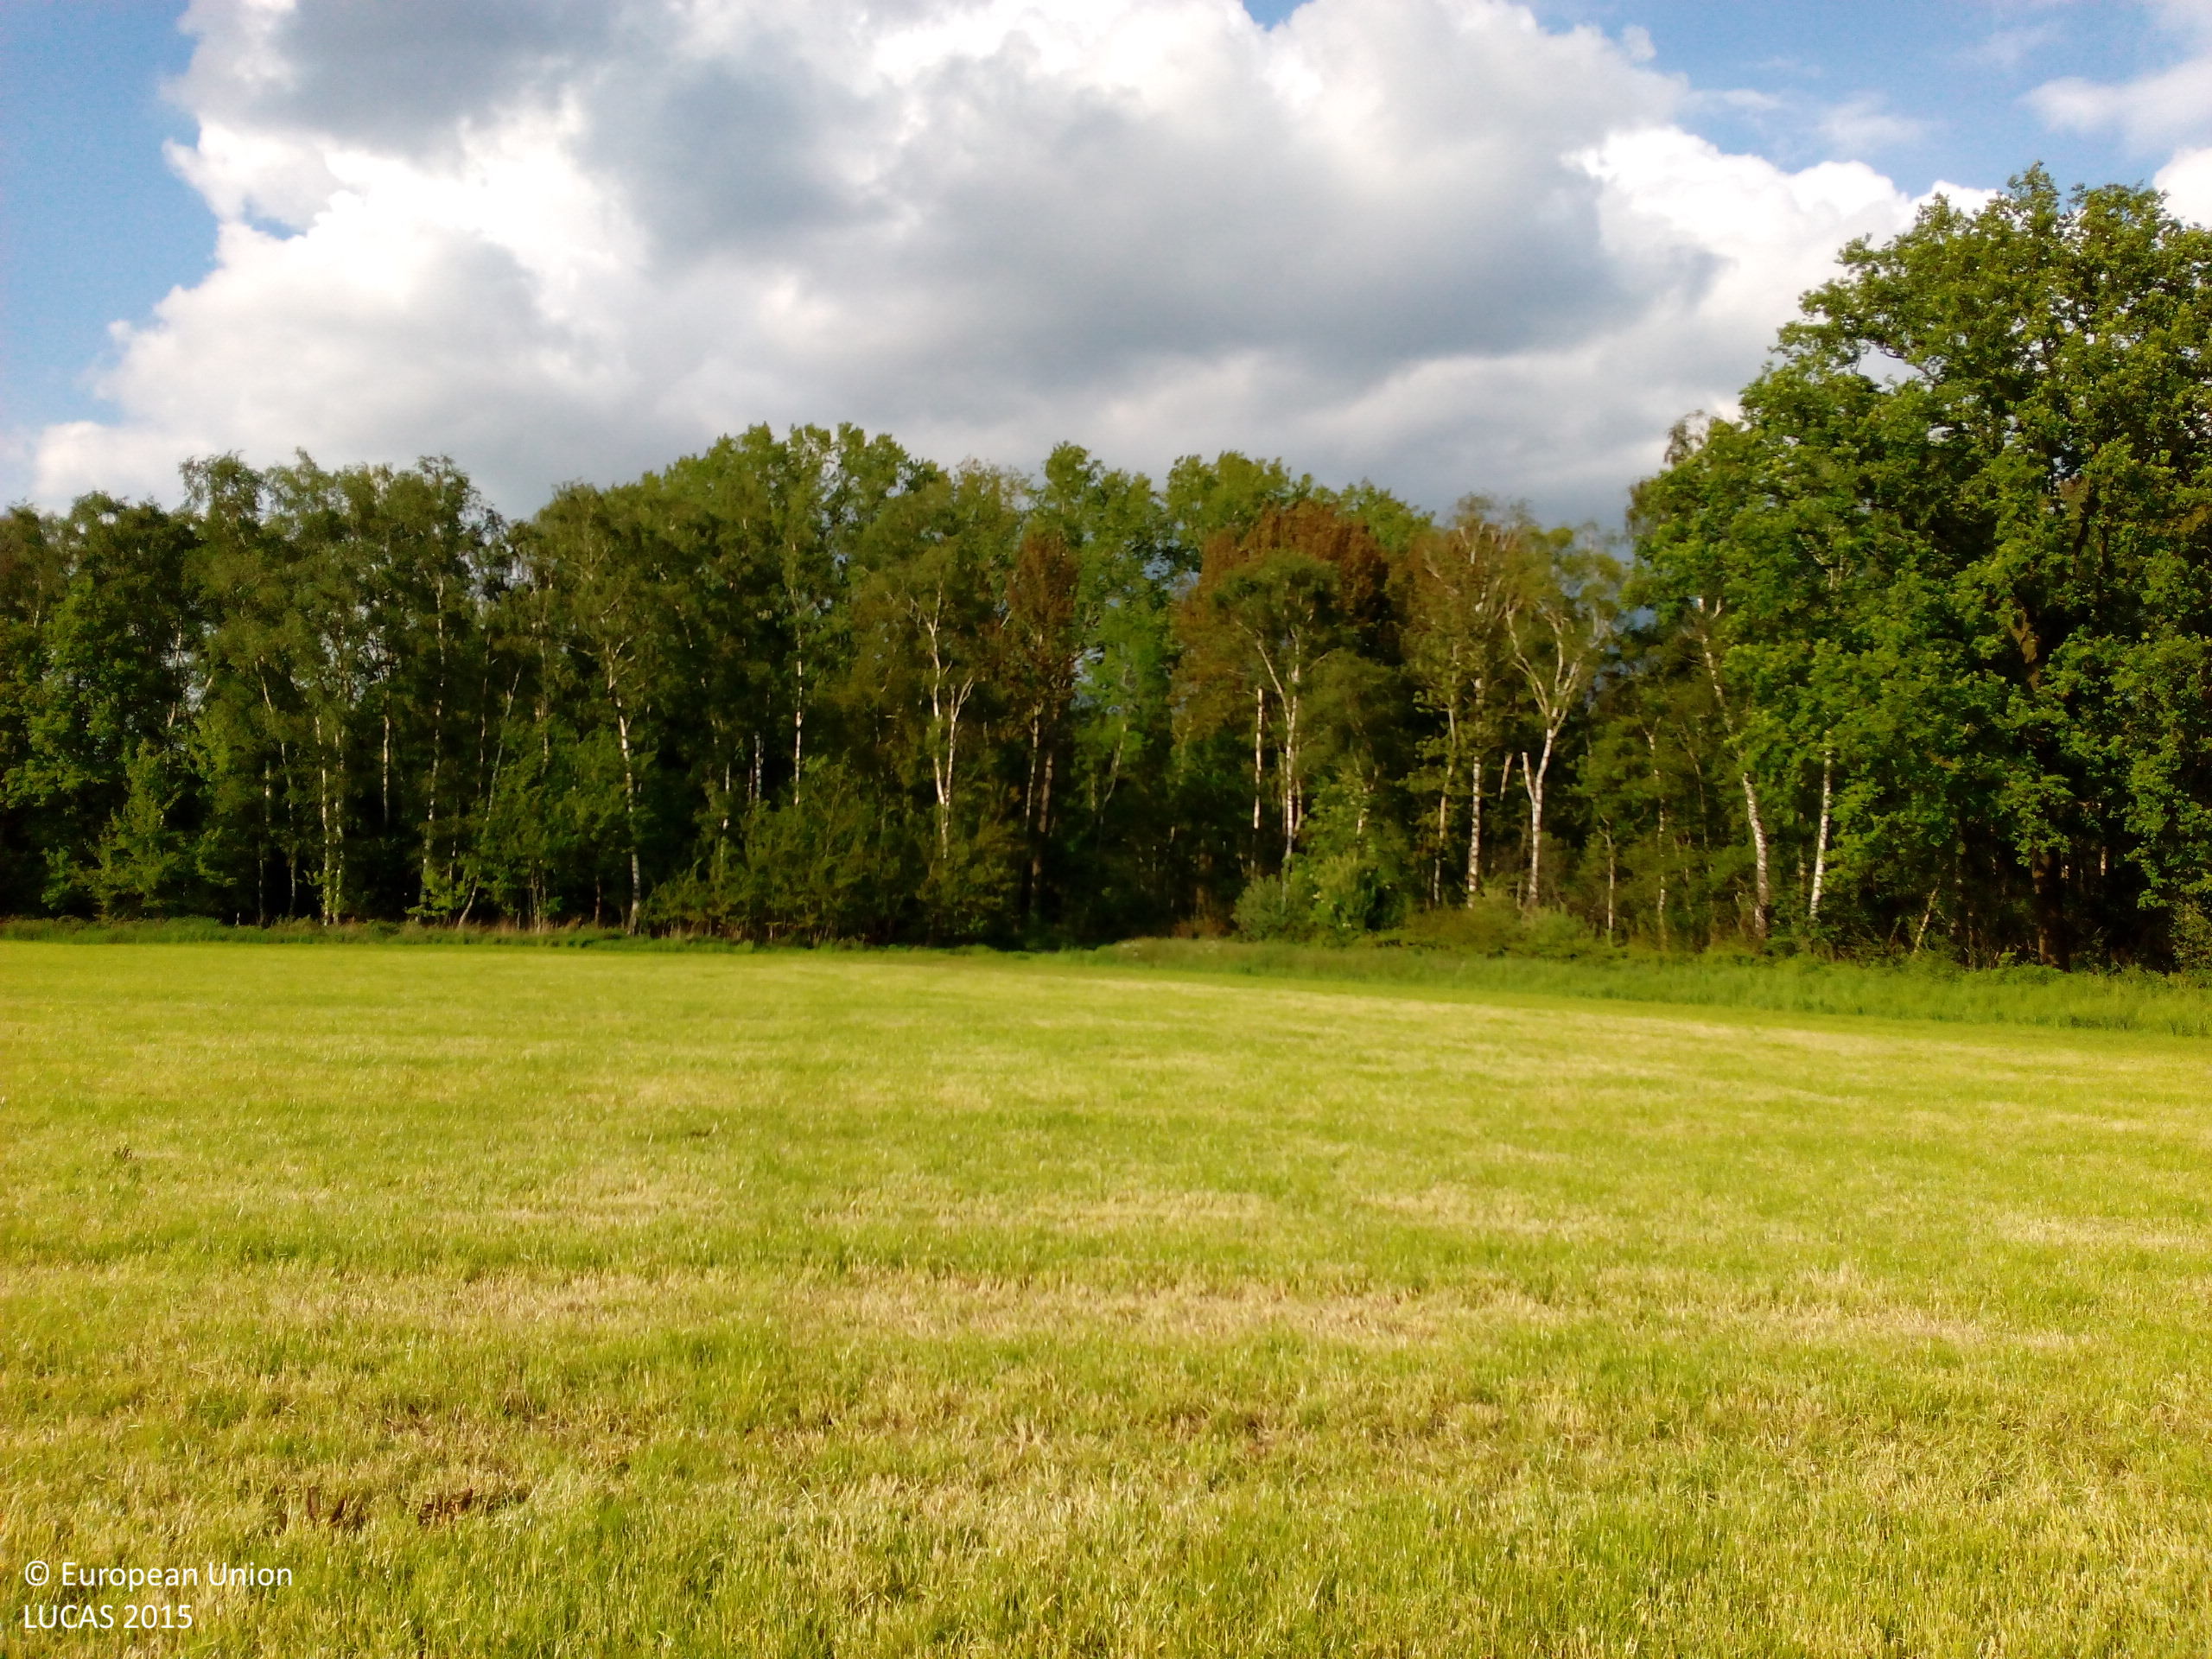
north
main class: Grassland
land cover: Grassland without tree/shrub cover
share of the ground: > 75 %
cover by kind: herbaceous plants 100 %
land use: Agriculture (excluding fallow land and kitchen gardens)
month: May
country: DE
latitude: 52.1881
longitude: 7.4405
